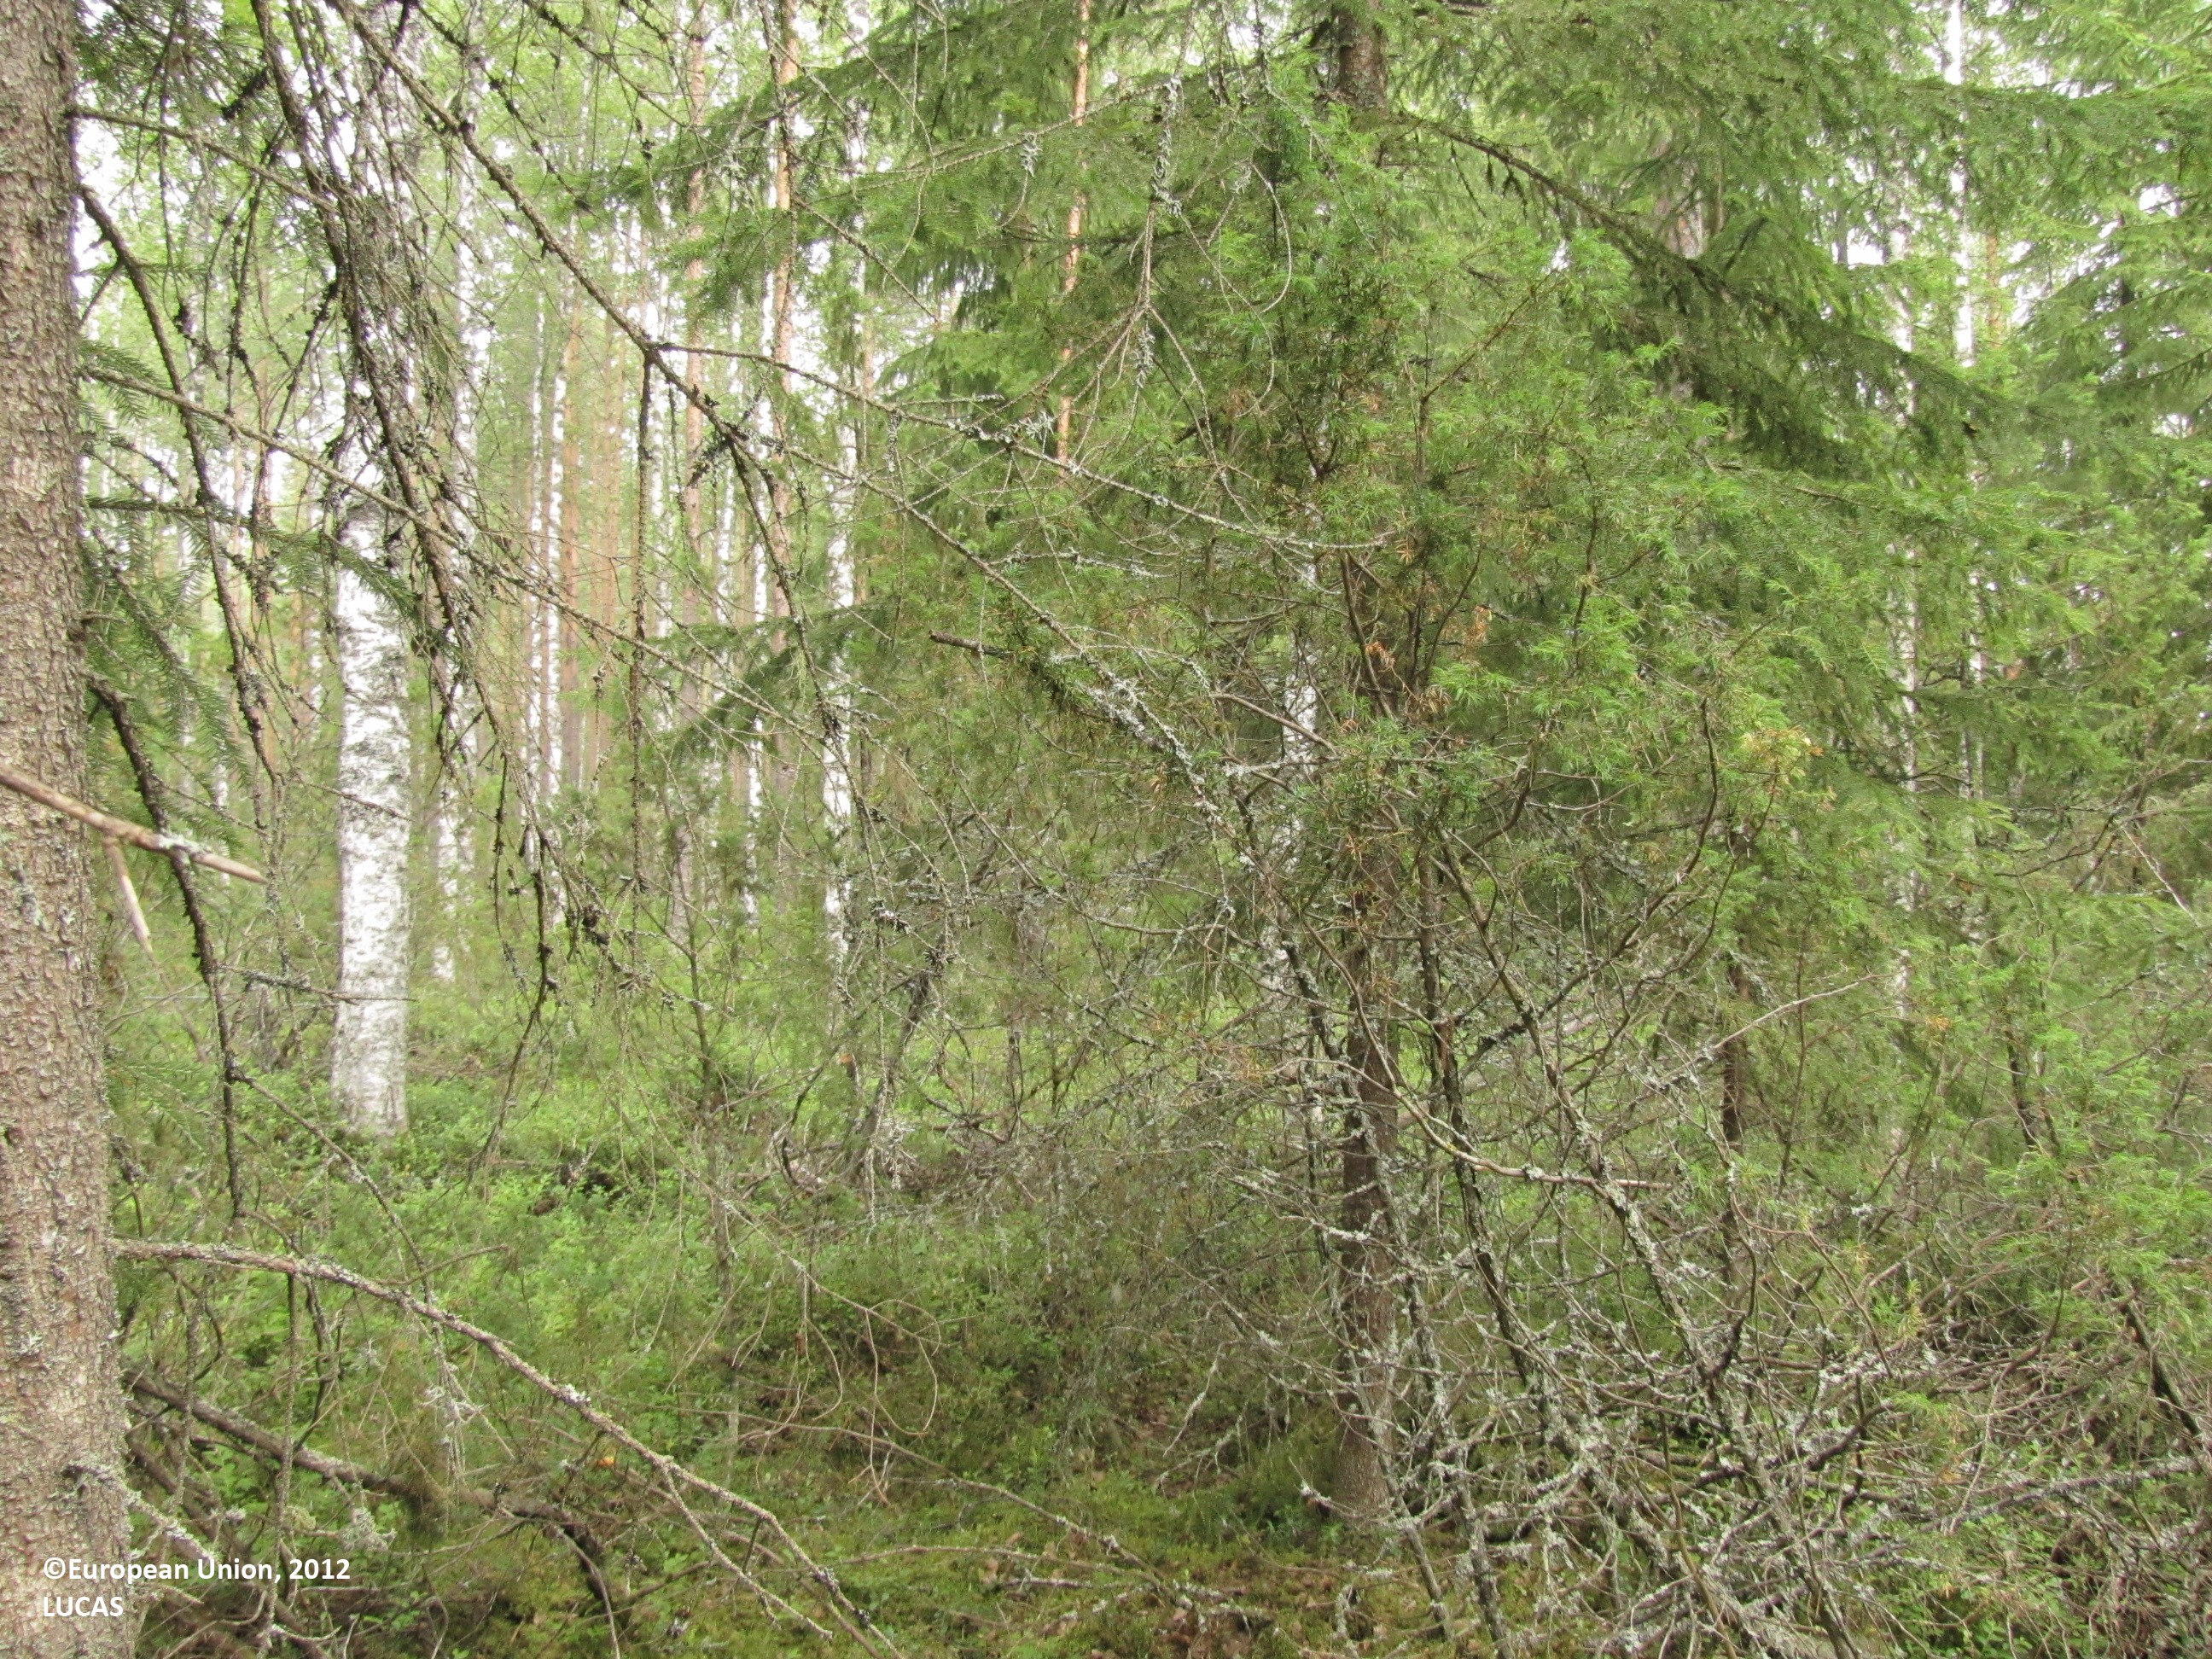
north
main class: Woodland
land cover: Other mixed woodland
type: boreal forest
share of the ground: > 75 %
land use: Forestry
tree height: > 5 m
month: July
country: FI
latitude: 62.6363
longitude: 22.9517
